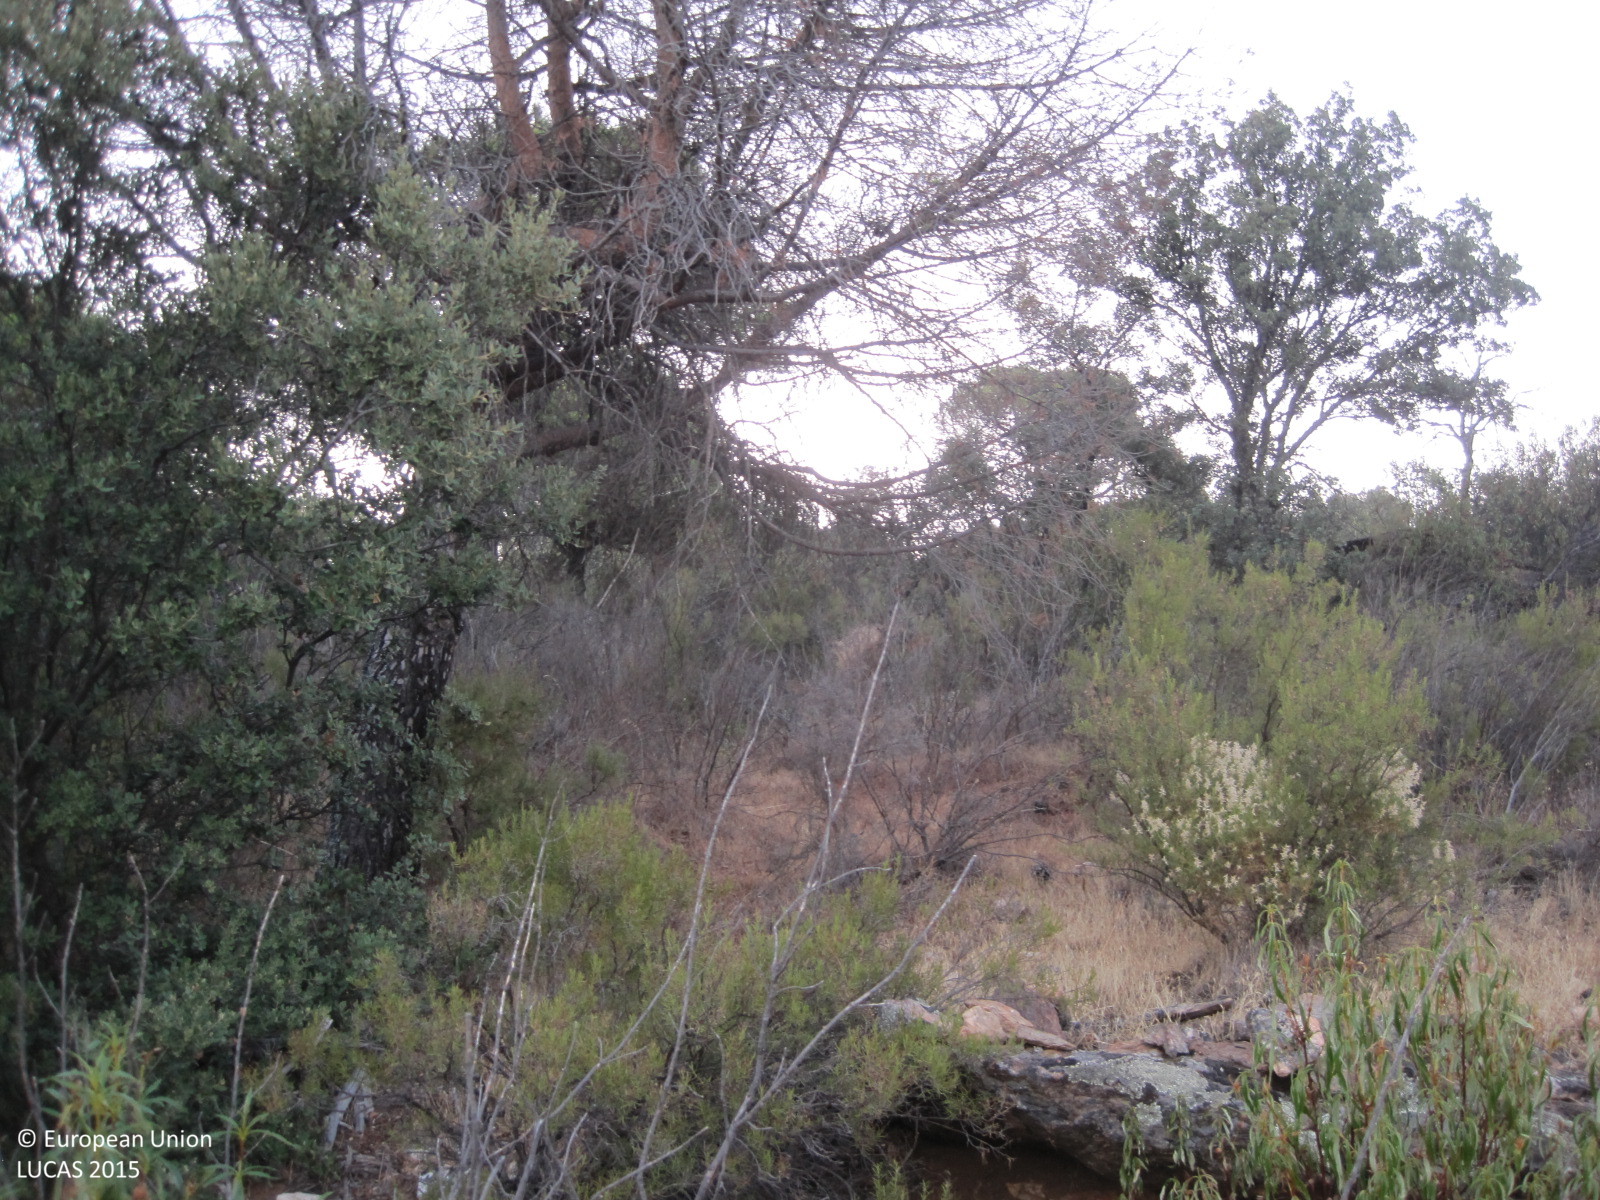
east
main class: Woodland
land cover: Pine dominated mixed woodland
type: coniferous forest of the mediterranean region
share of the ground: > 75 %
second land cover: Shrubland without tree cover
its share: 50 - 75 %
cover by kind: coniferous forest trees 70 %, broadleaved forest trees 30 %
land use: Forestry
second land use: Agriculture (excluding fallow land and kitchen gardens)
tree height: > 5 m
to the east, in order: Pine dominated mixed woodland; Shrubland without tree cover
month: July
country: ES
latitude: 40.3047
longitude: -4.3643
